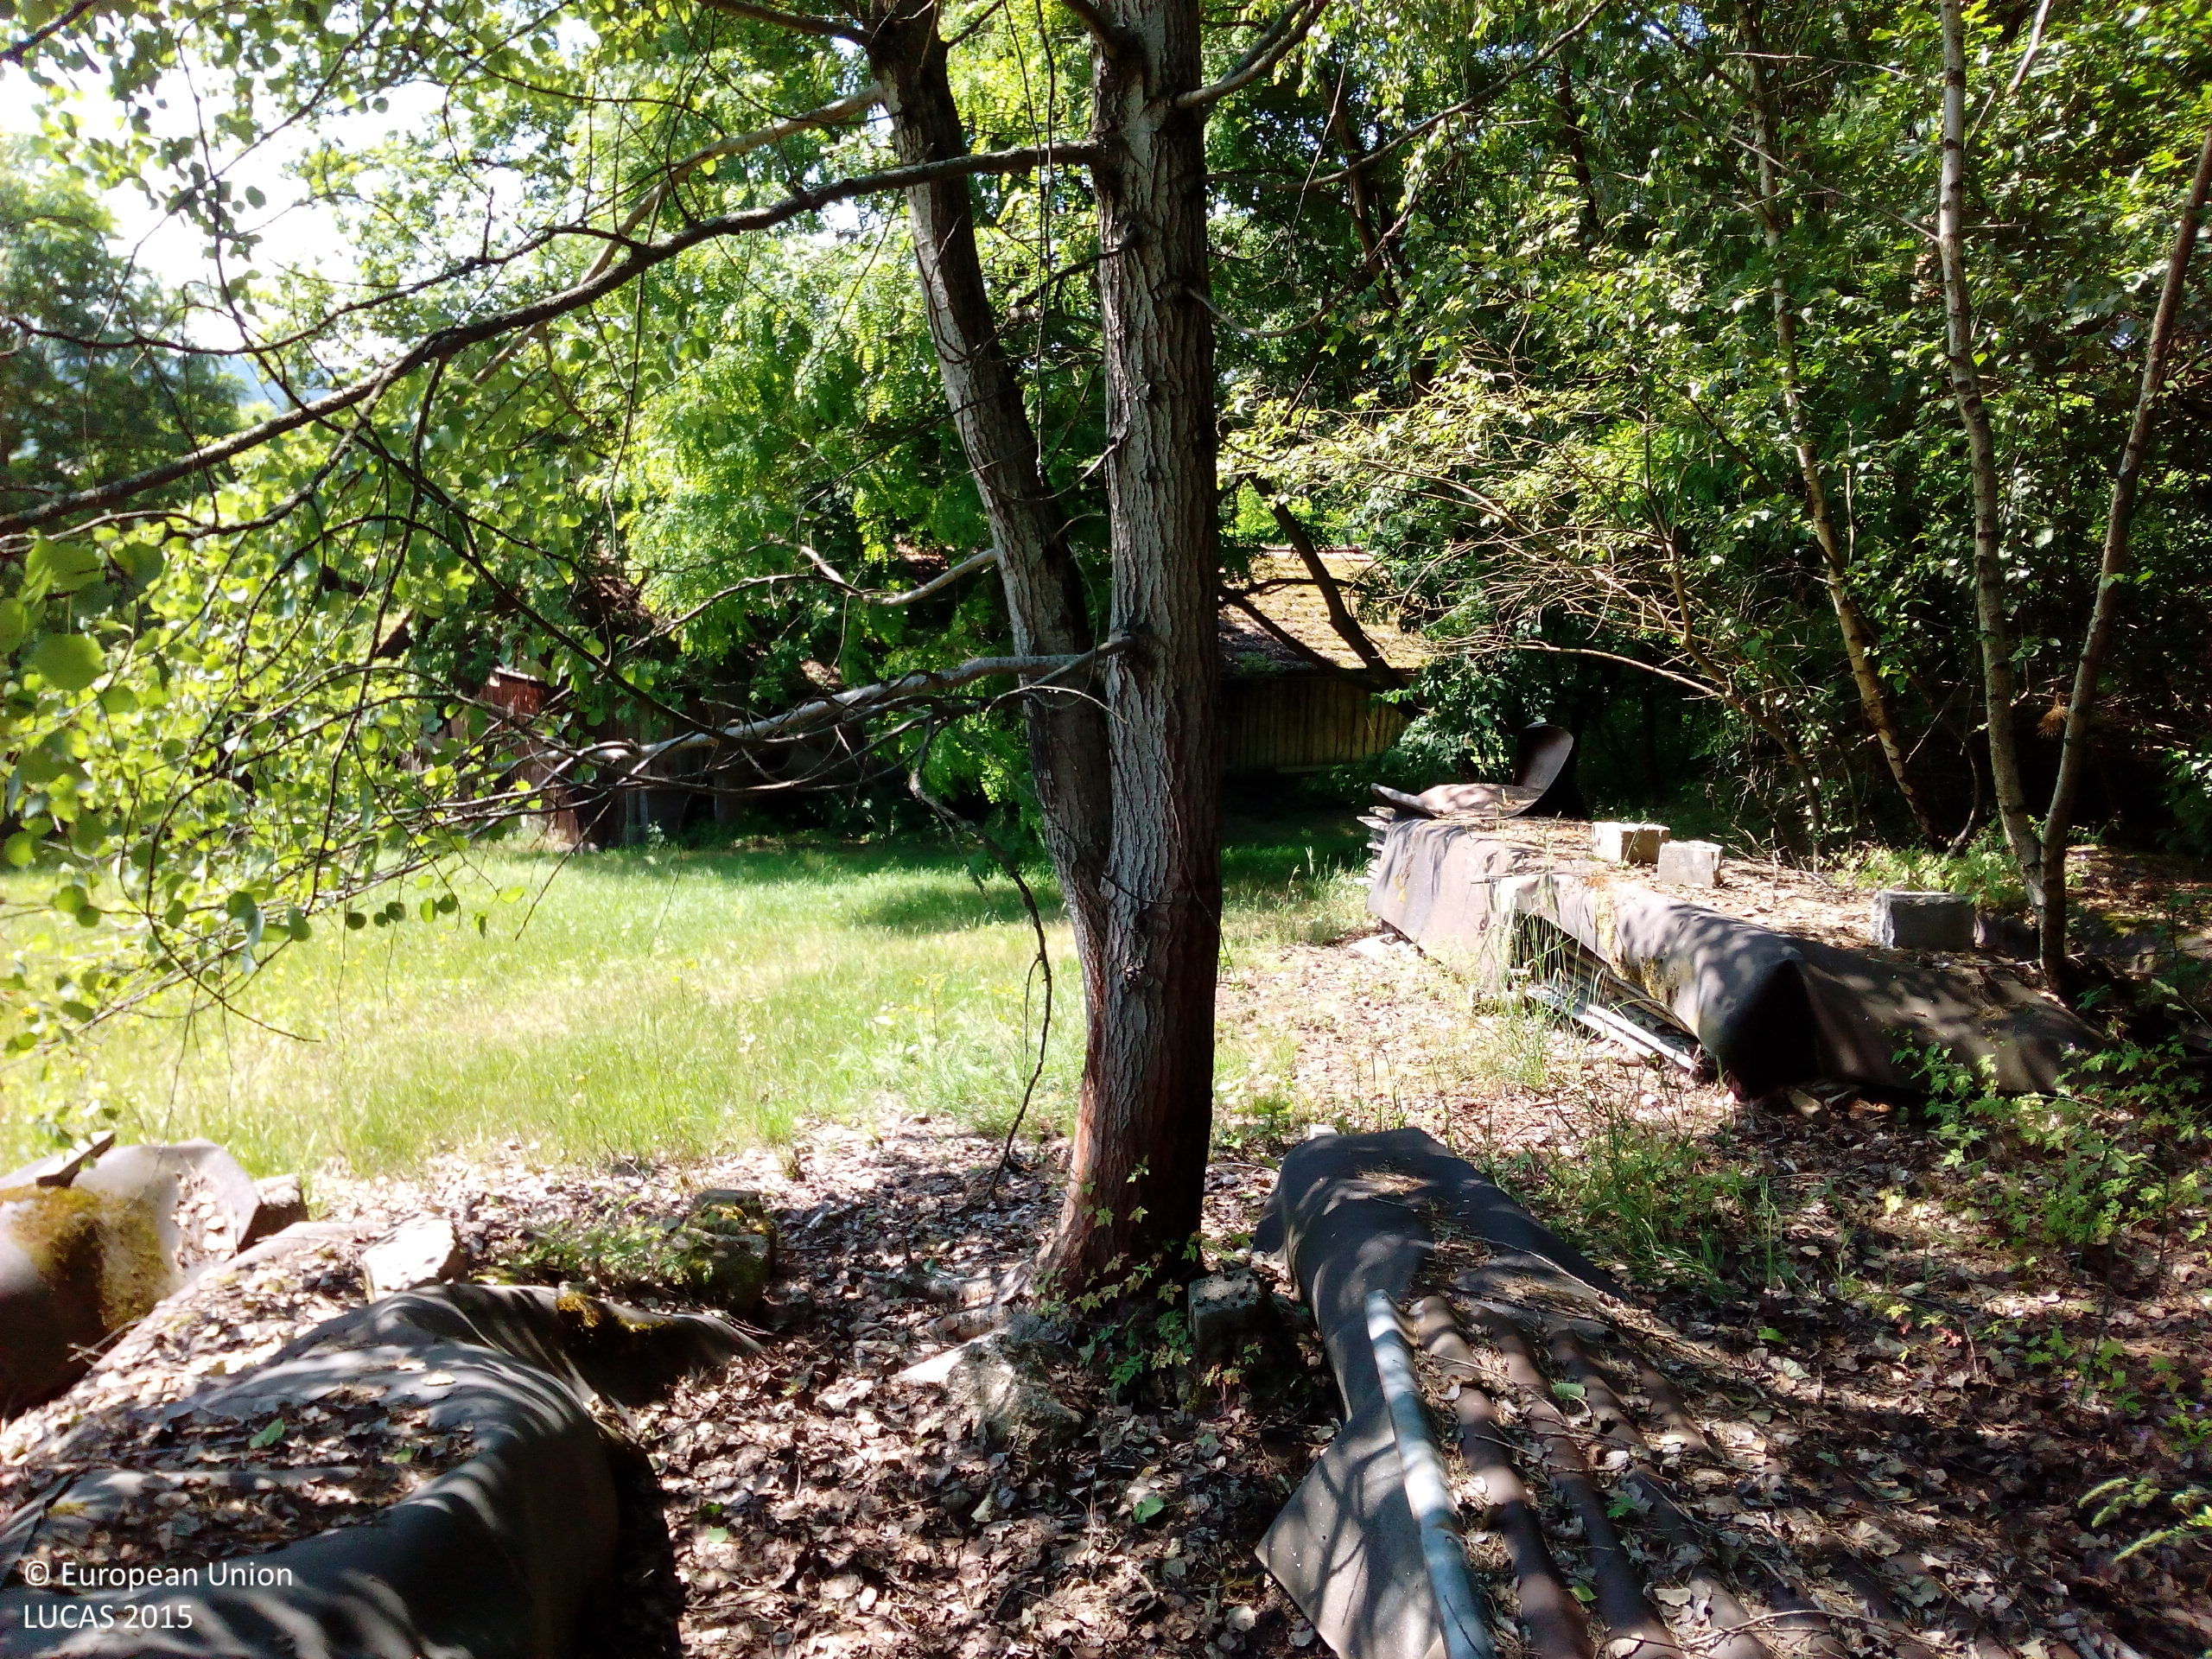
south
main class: Woodland
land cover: Broadleaved woodland
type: mesophytic deciduous forest
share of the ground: > 75 %
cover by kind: broadleaved forest trees 45 %, herbaceous plants 10 %, coniferous forest trees 5 %, lichens and mosses 5 %, unconsolidated bare surface 5 %
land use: Logistics and storage
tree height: > 5 m
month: June
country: DE
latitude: 49.1885
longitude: 12.3457
